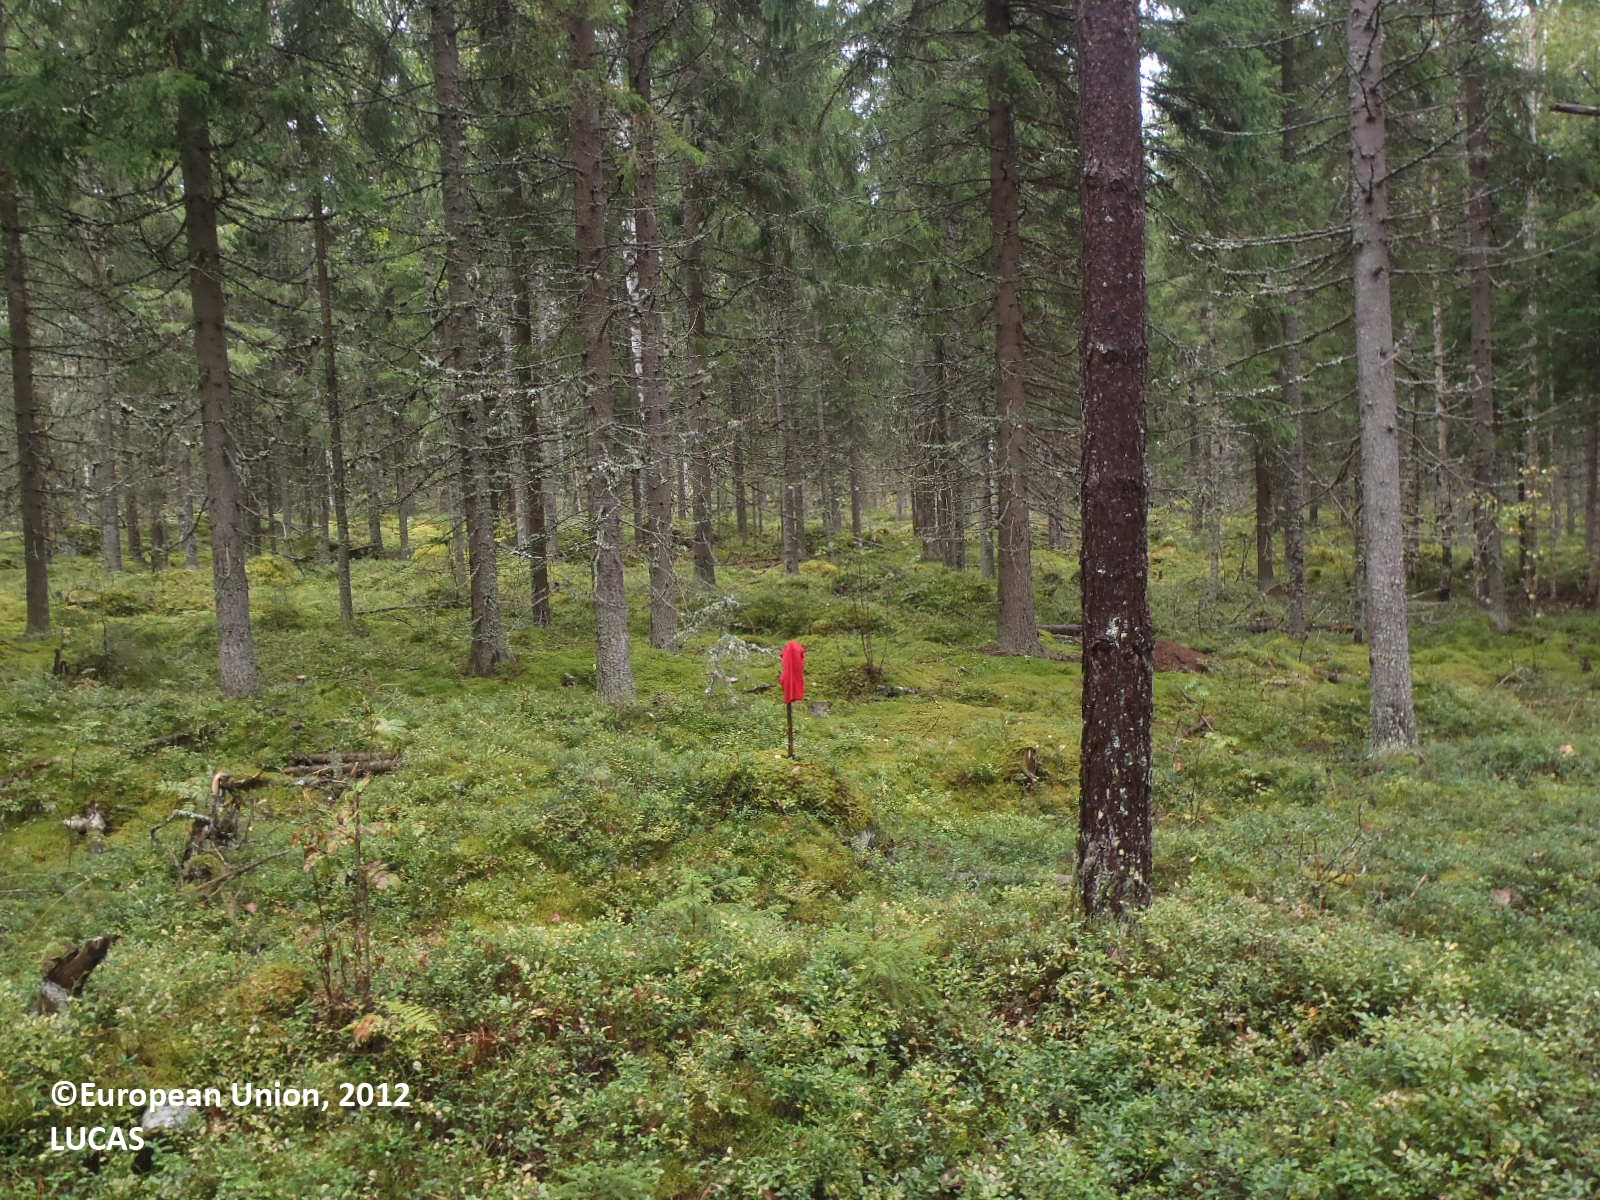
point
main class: Woodland
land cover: Spruce dominated coniferous woodland
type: boreal forest
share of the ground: > 75 %
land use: Forestry
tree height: > 5 m
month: September
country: FI
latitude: 61.6032
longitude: 22.8285
